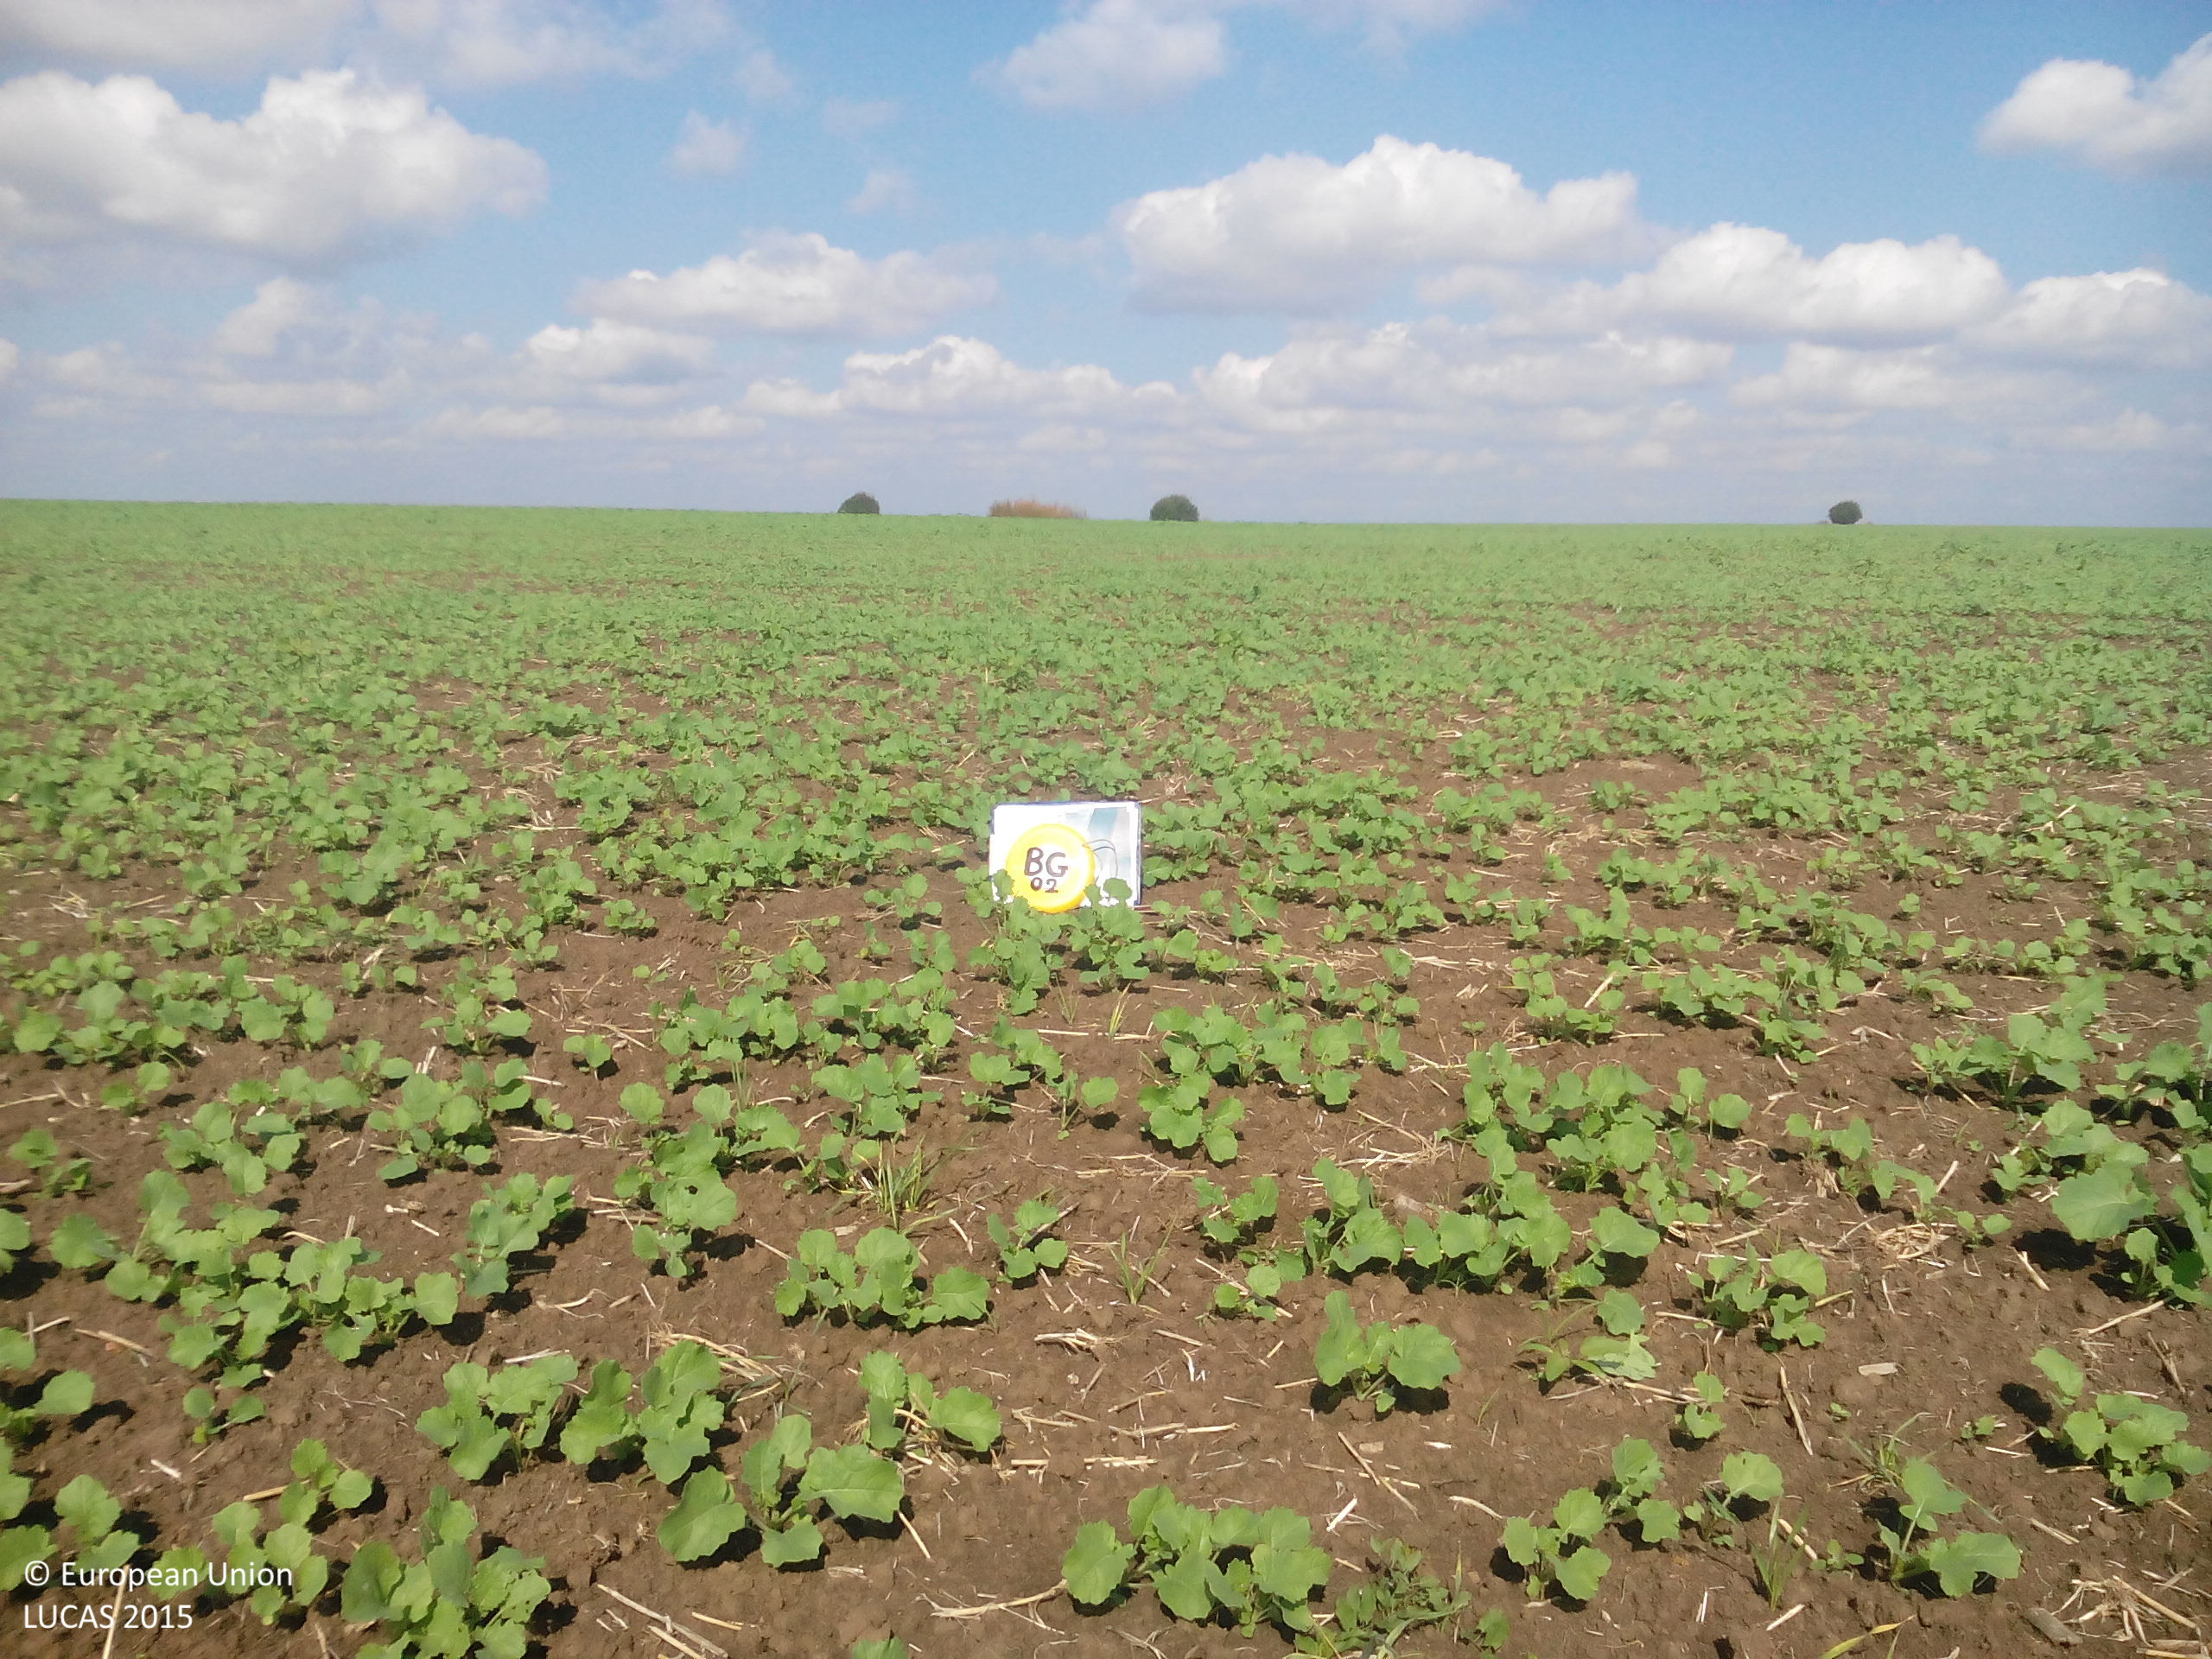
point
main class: Cropland
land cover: Rape and turnip rape
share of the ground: 25 - 50 %
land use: Agriculture (excluding fallow land and kitchen gardens)
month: October
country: BG
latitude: 43.3996
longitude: 23.8408
